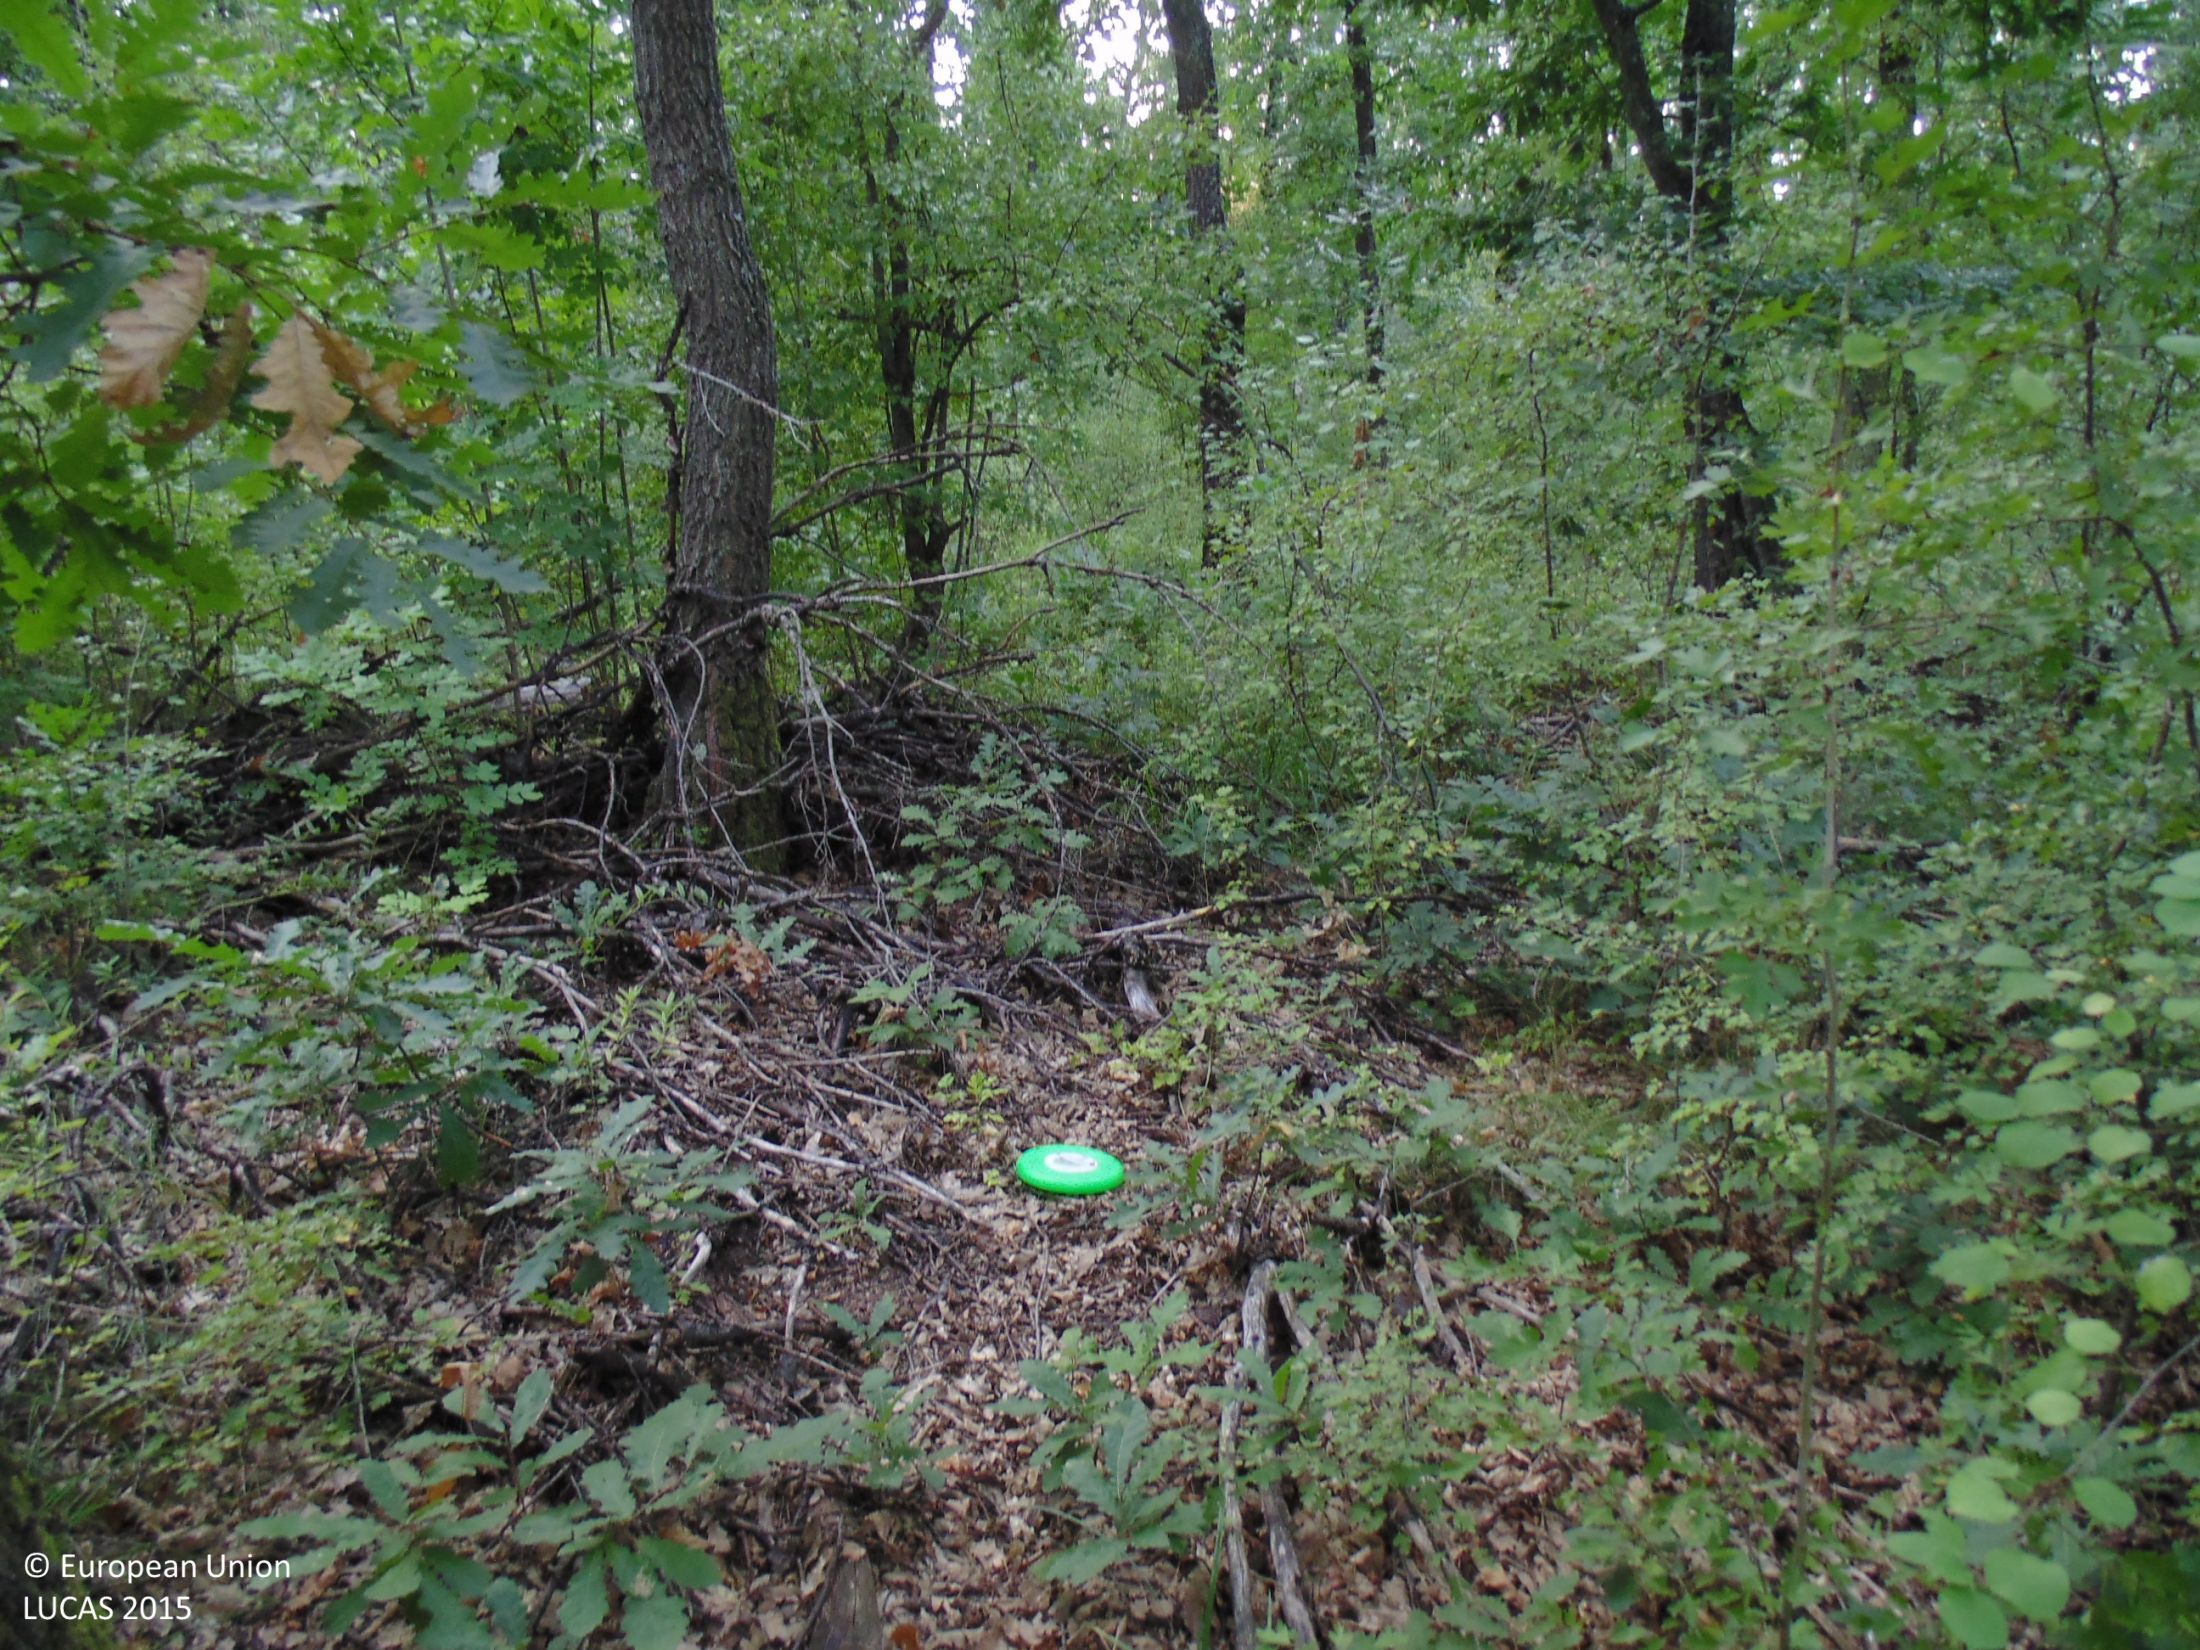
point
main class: Woodland
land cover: Broadleaved woodland
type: mesophytic deciduous forest
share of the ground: > 75 %
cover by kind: broadleaved forest trees 90 %, shrubs 5 %, unconsolidated bare surface 5 %
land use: Forestry
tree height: > 5 m
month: August
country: BG
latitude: 43.8029
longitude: 27.5248
